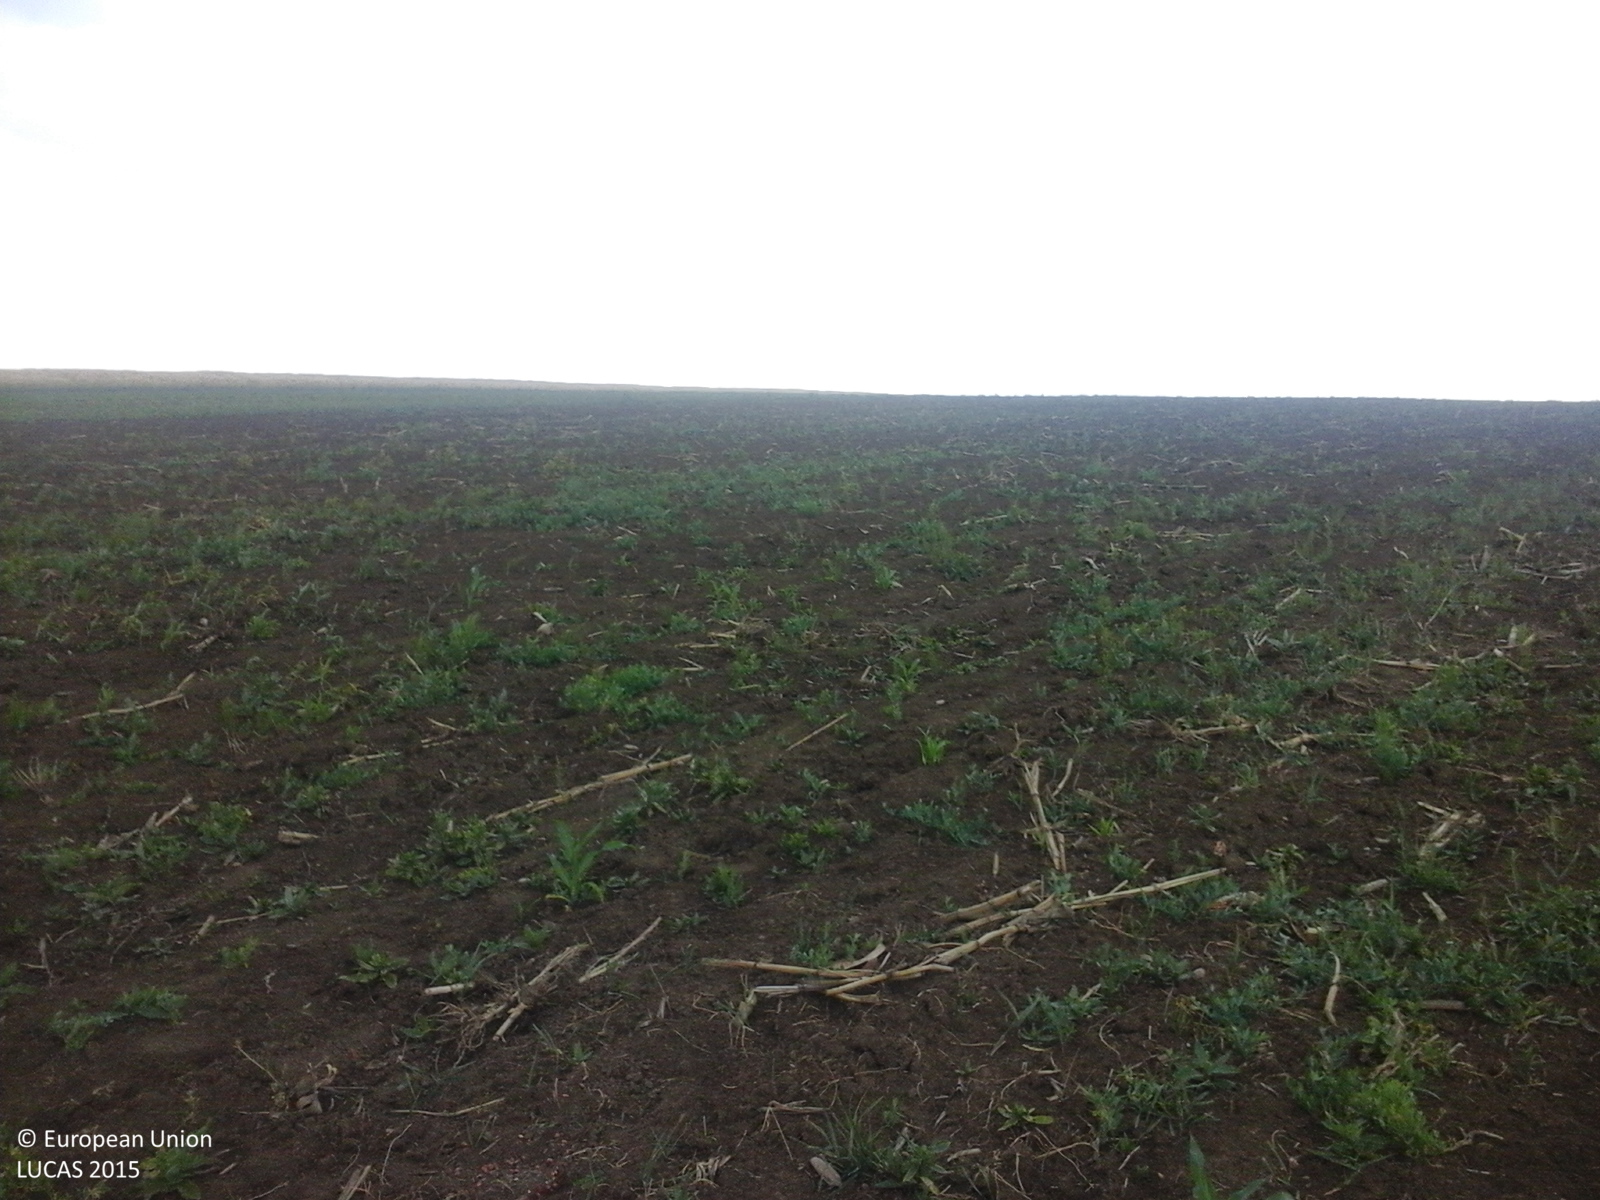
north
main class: Cropland
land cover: Maize
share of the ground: < 10 %
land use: Agriculture (excluding fallow land and kitchen gardens)
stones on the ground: < 10 %
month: June
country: RO
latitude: 47.3168
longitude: 26.5055
